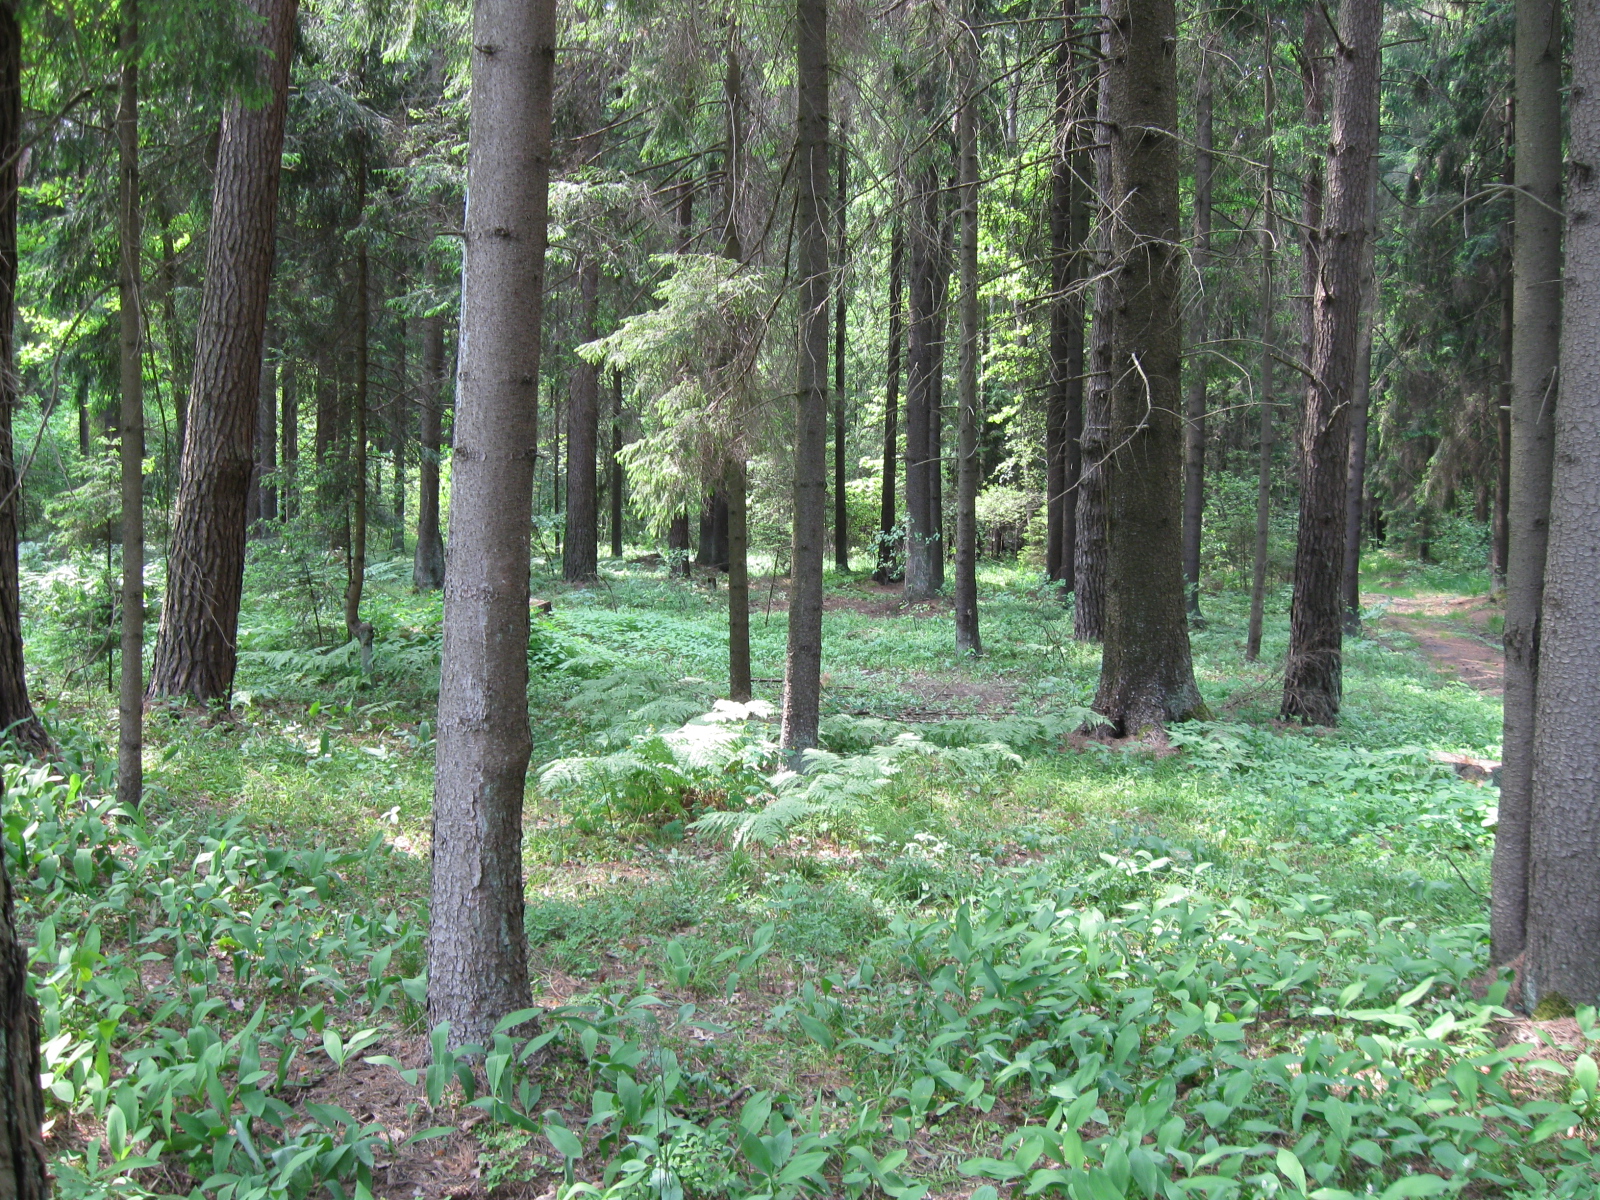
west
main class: Woodland
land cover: Spruce dominated coniferous woodland
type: hemiboreal forest and nemoral coniferous forest and mixed broadleaved-coniferous forest
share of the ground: > 75 %
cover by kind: coniferous forest trees 85 %, herbaceous plants 10 %, unconsolidated bare surface 5 %
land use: Forestry
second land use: Sport
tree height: > 5 m
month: June
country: LT
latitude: 54.9433
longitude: 23.9684
